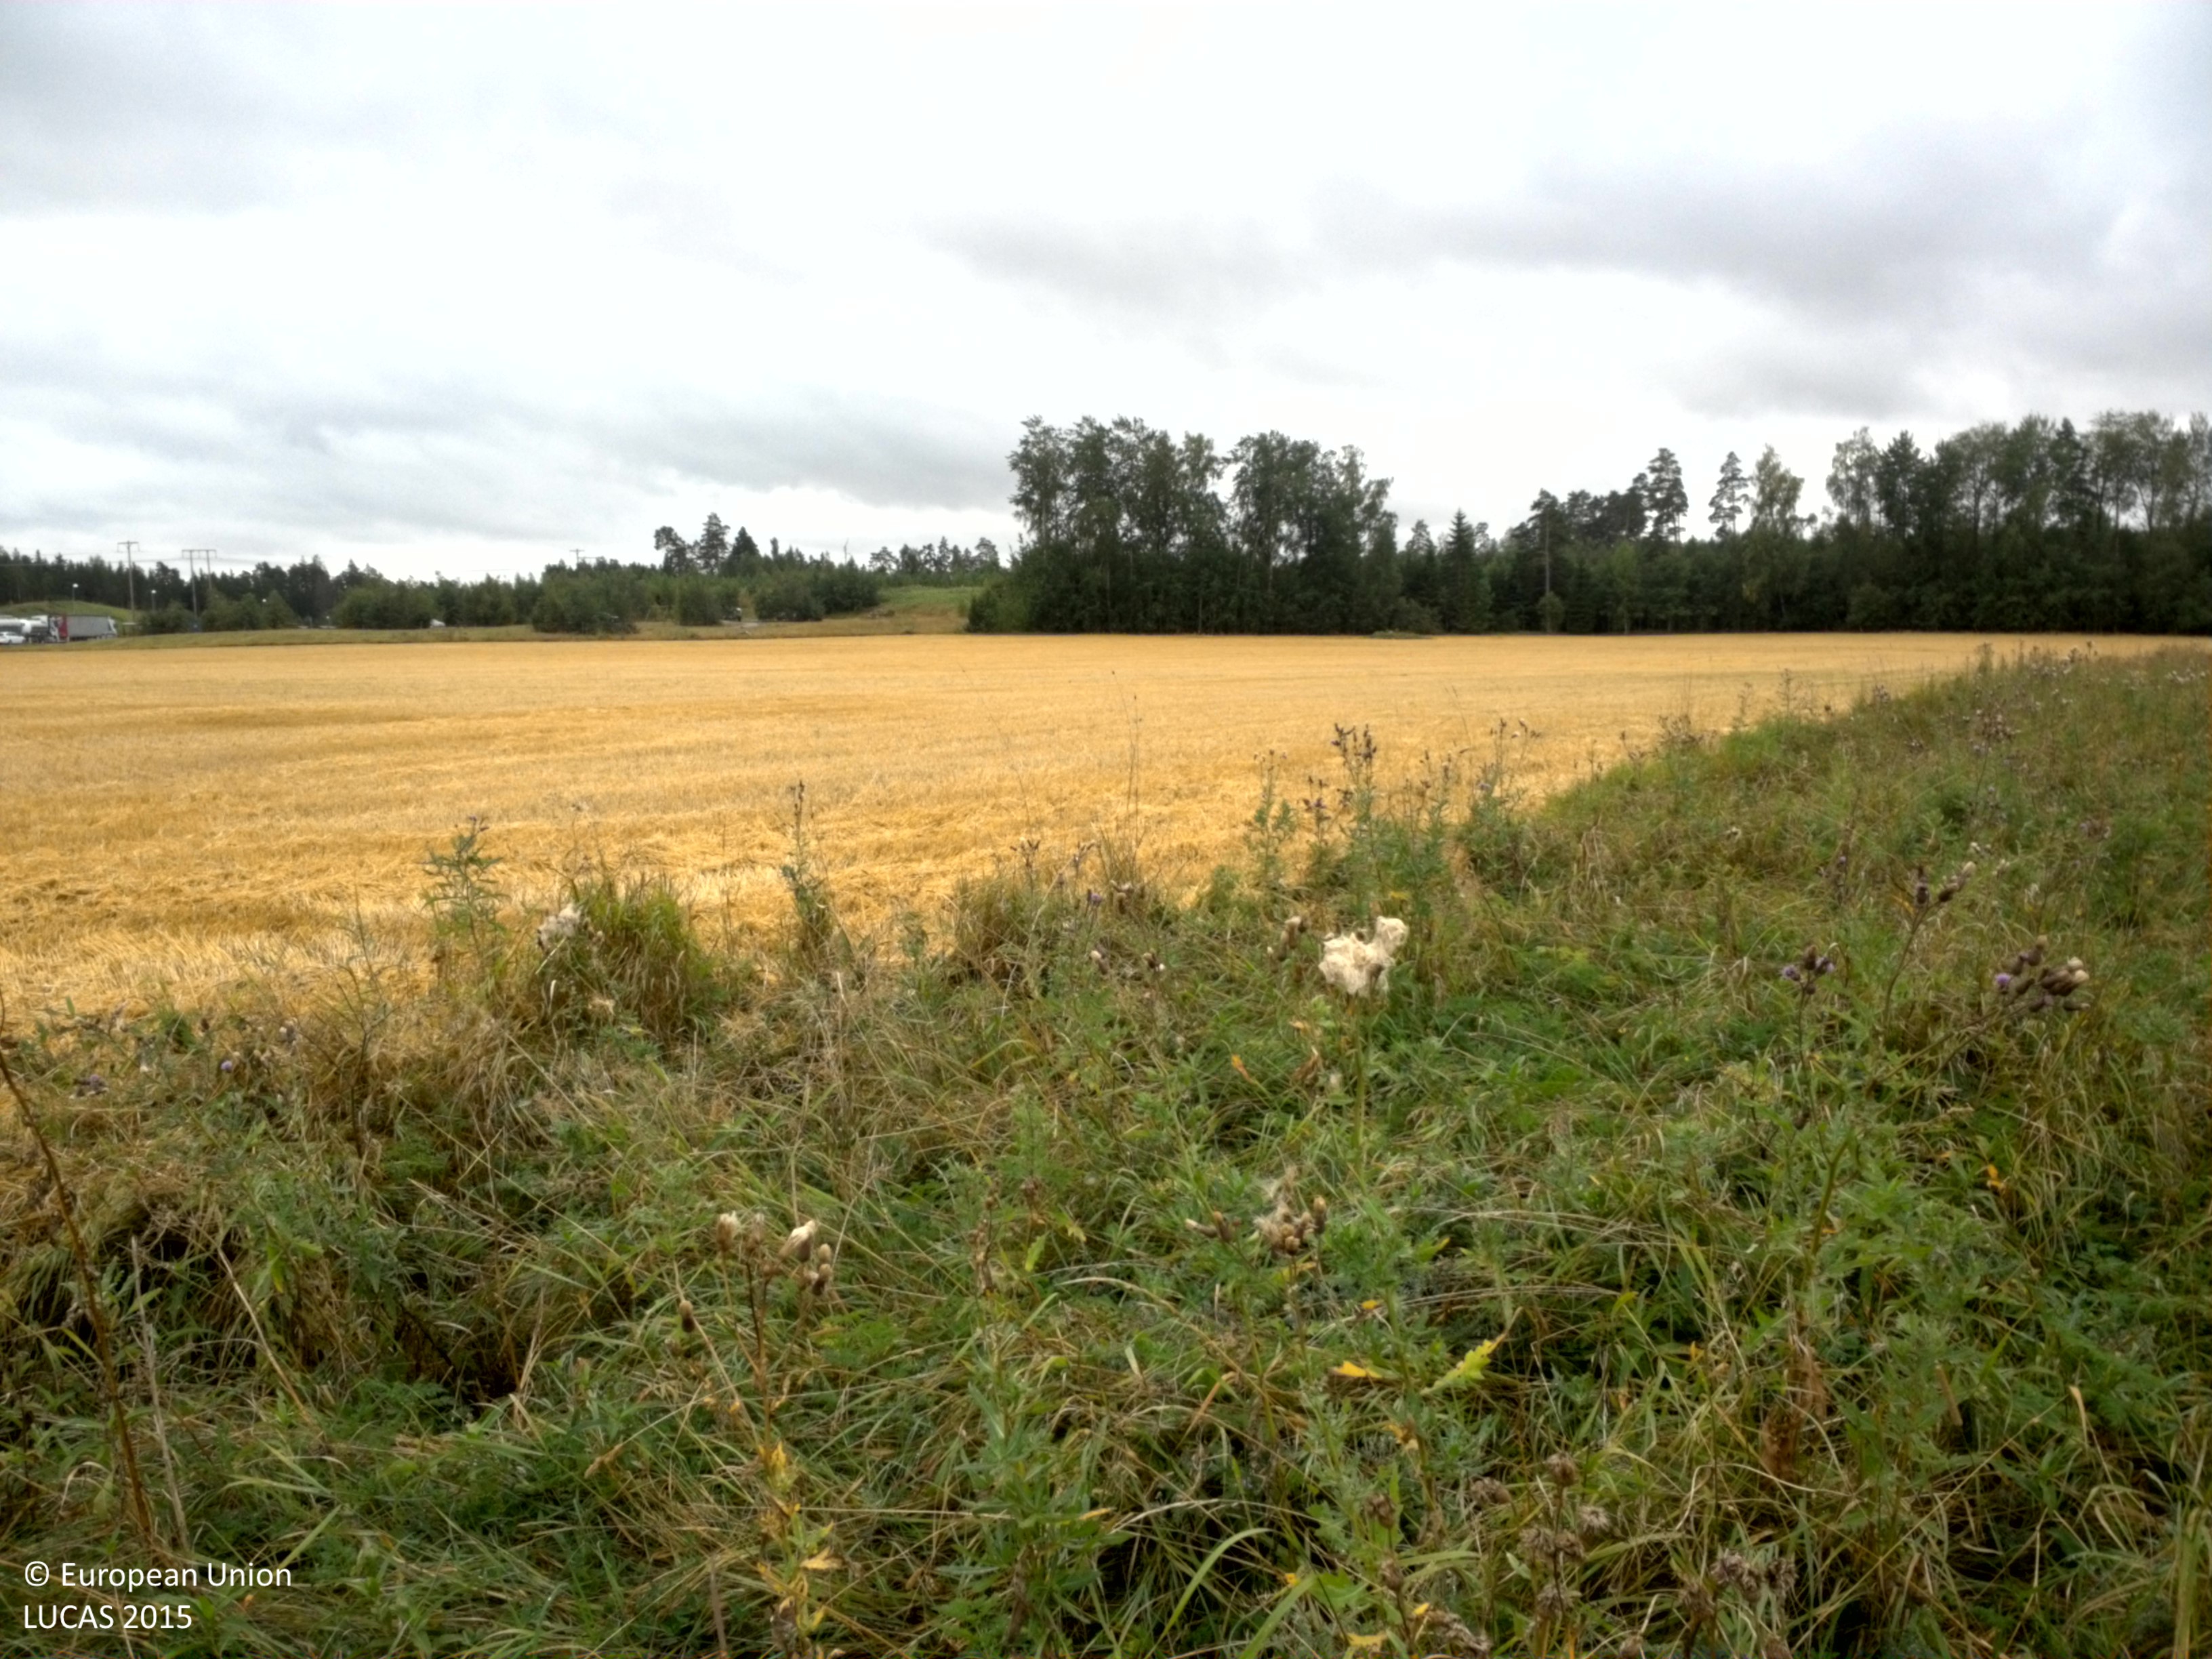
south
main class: Grassland
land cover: Grassland without tree/shrub cover
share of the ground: > 75 %
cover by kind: herbaceous plants 100 %
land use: Agriculture (excluding fallow land and kitchen gardens)
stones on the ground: < 10 %
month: August
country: SE
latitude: 59.9732
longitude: 17.6439
